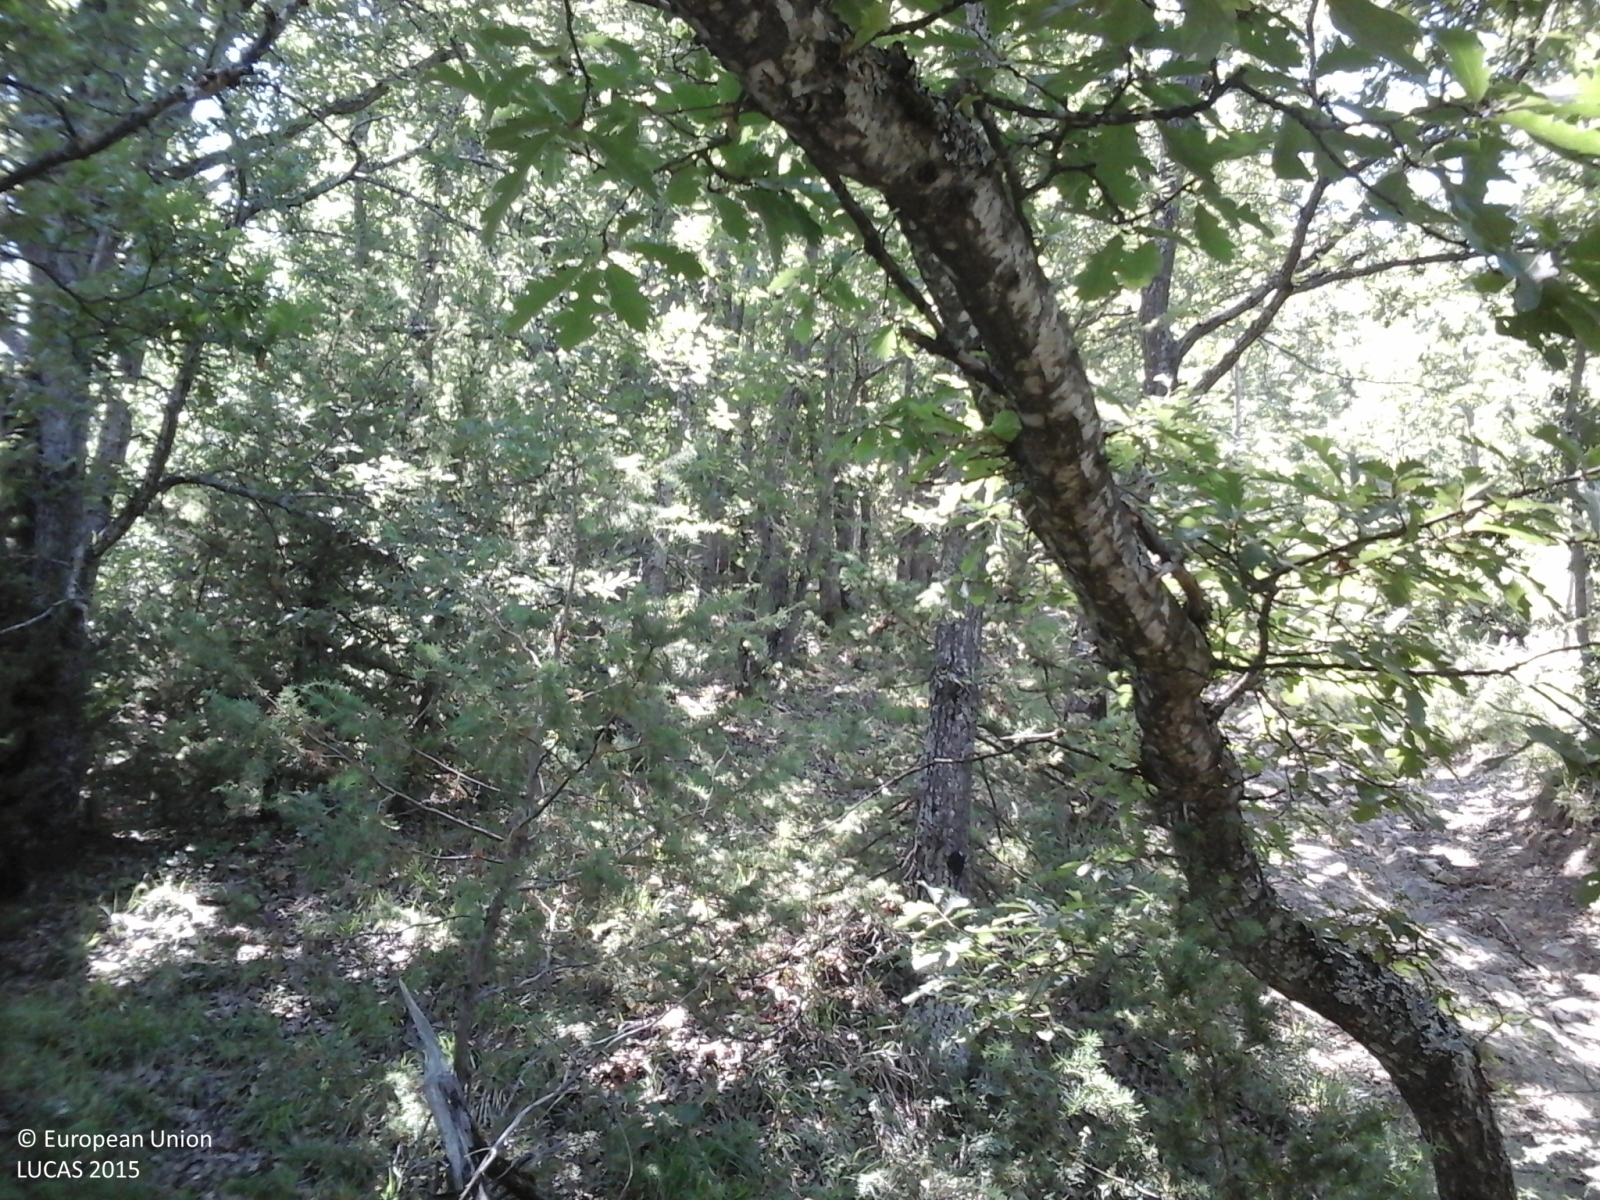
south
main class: Woodland
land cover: Broadleaved woodland
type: thermophilous deciduous forest
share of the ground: > 75 %
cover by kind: broadleaved forest trees 100 %
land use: Forestry
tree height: > 5 m
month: June
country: IT
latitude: 42.7284
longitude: 13.2512
